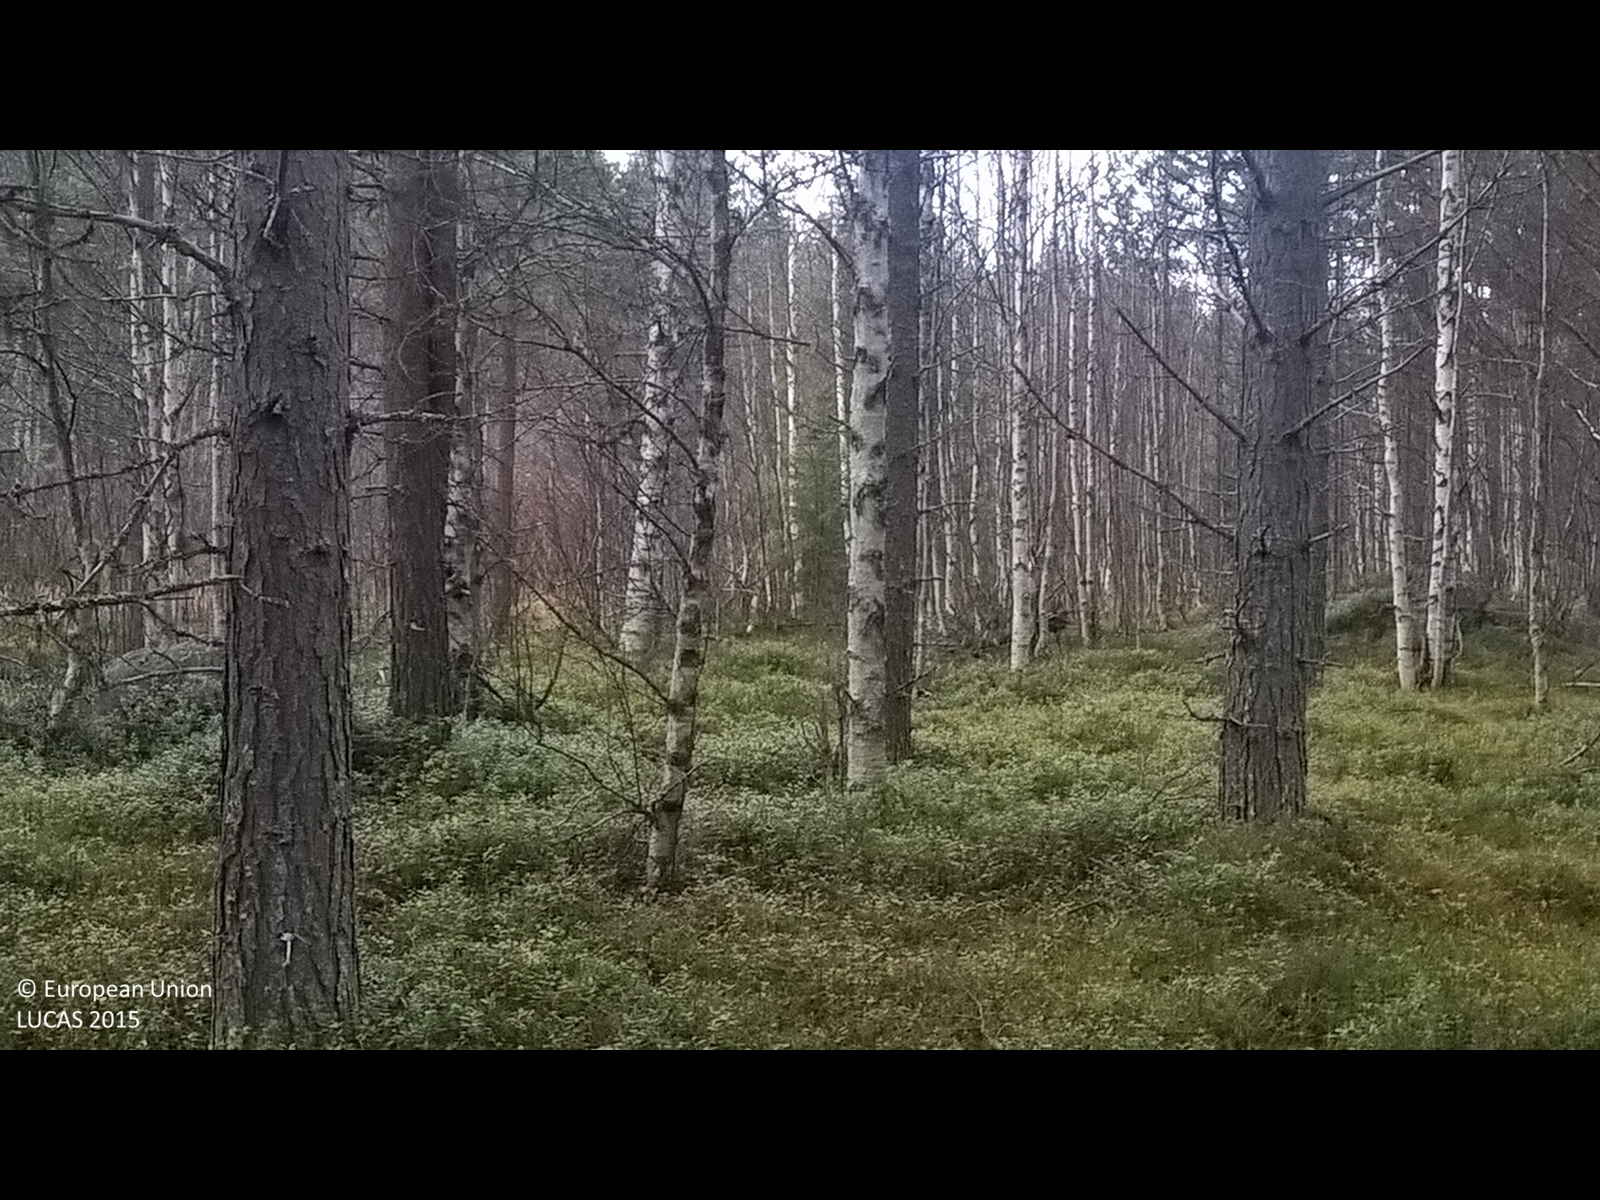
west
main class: Woodland
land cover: Pine dominated mixed woodland
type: boreal forest
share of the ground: > 75 %
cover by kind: coniferous forest trees 40 %, broadleaved forest trees 40 %, shrubs 20 %
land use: Forestry
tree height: > 5 m
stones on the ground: < 10 %
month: October
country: SE
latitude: 65.1294
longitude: 17.8685
